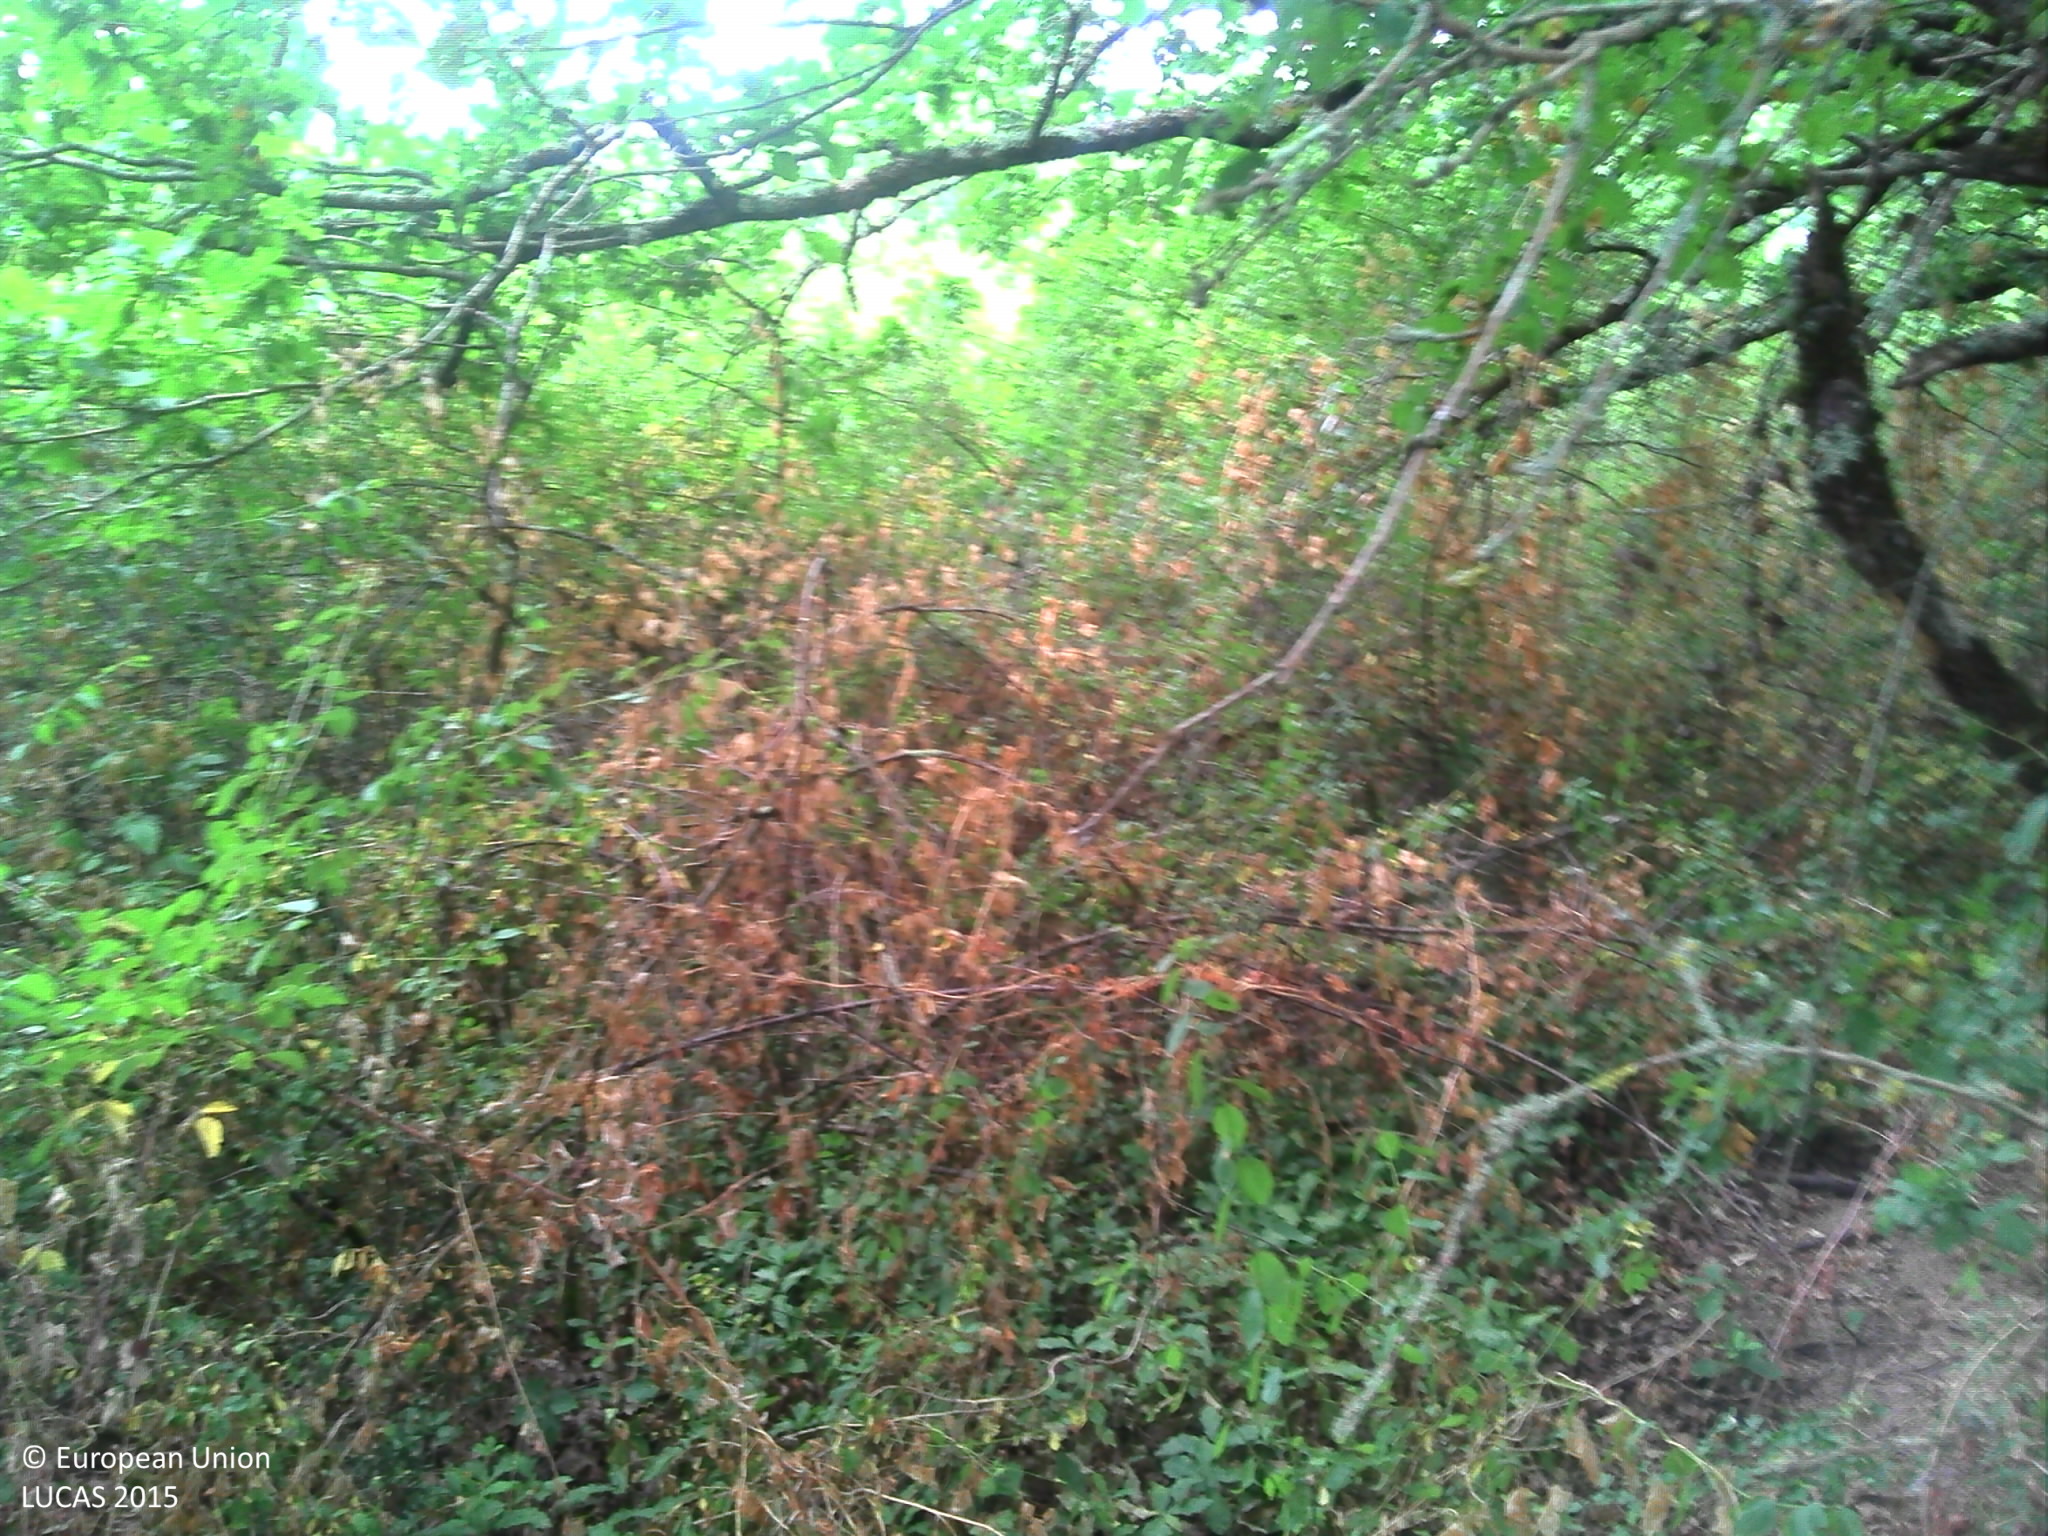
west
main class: Woodland
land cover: Broadleaved woodland
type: mesophytic deciduous forest
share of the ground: > 75 %
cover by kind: broadleaved forest trees 80 %, herbaceous plants 15 %
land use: Forestry
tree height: > 5 m
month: October
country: FR
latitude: 46.3316
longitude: 1.1940
